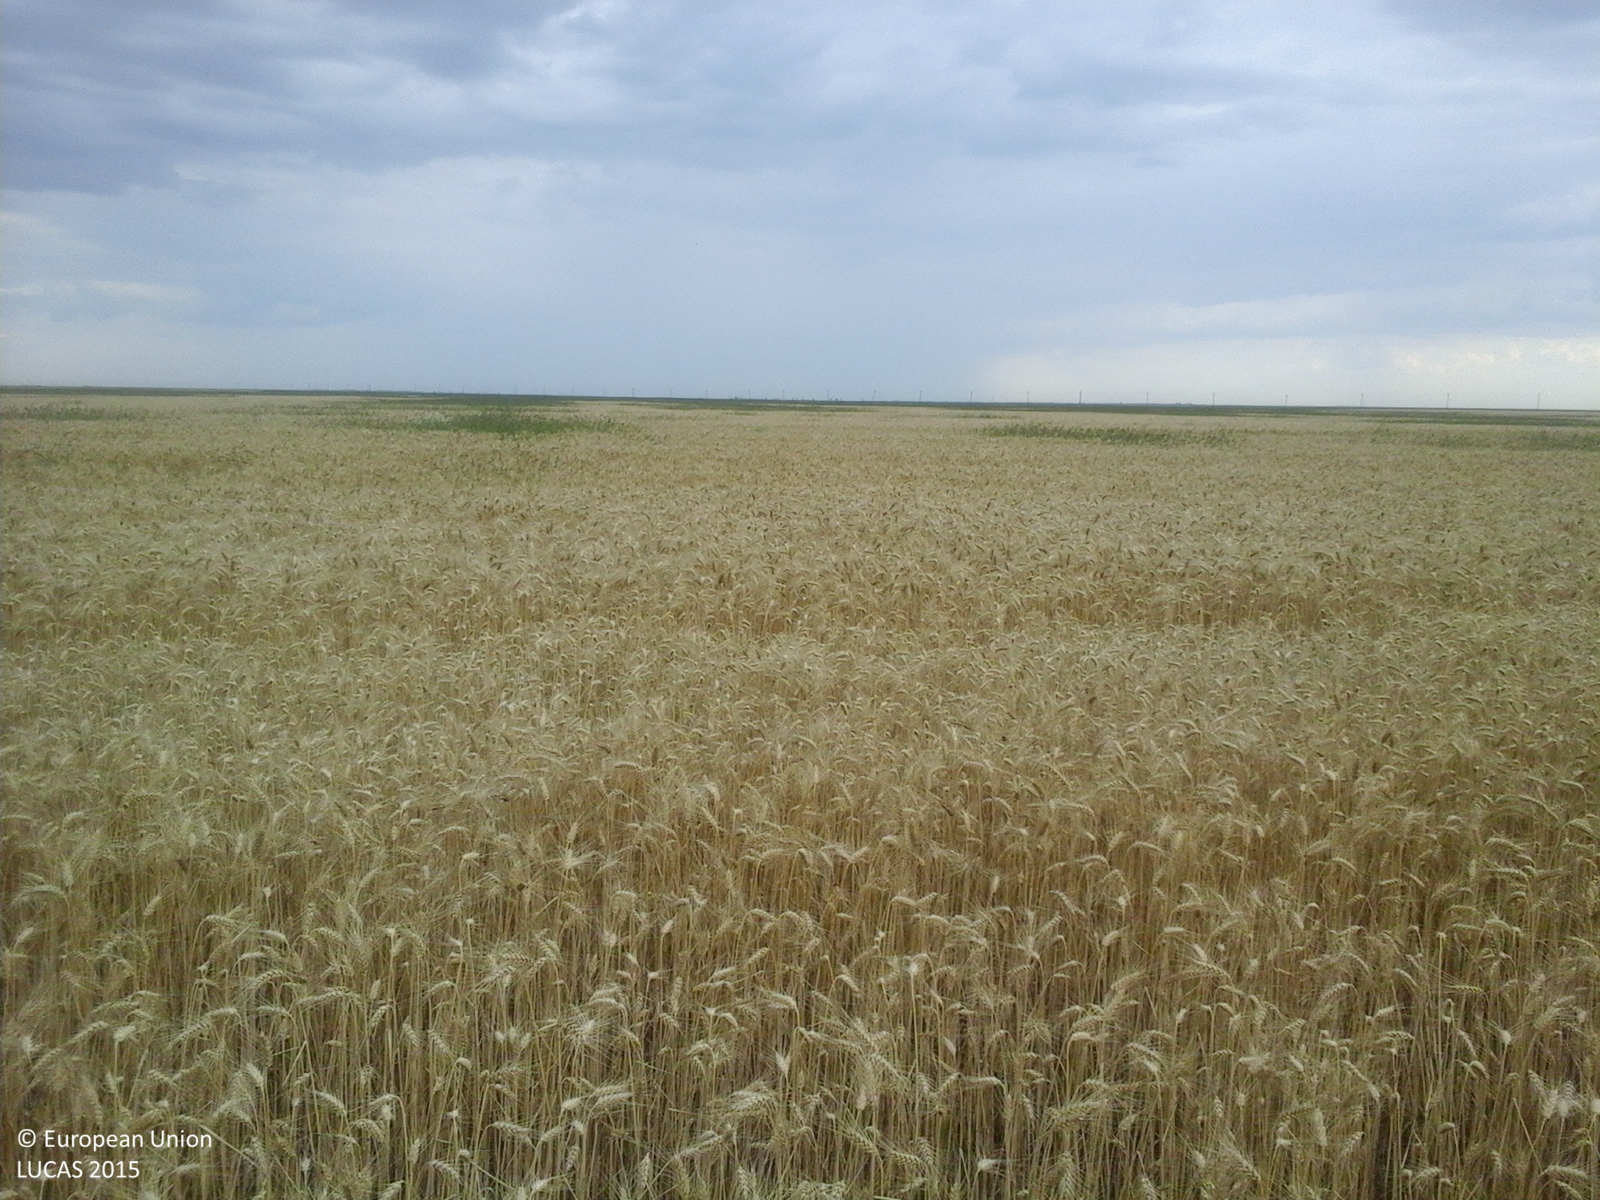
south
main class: Cropland
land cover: Common wheat
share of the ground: > 75 %
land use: Agriculture (excluding fallow land and kitchen gardens)
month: July
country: RO
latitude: 44.4234
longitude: 24.8869
